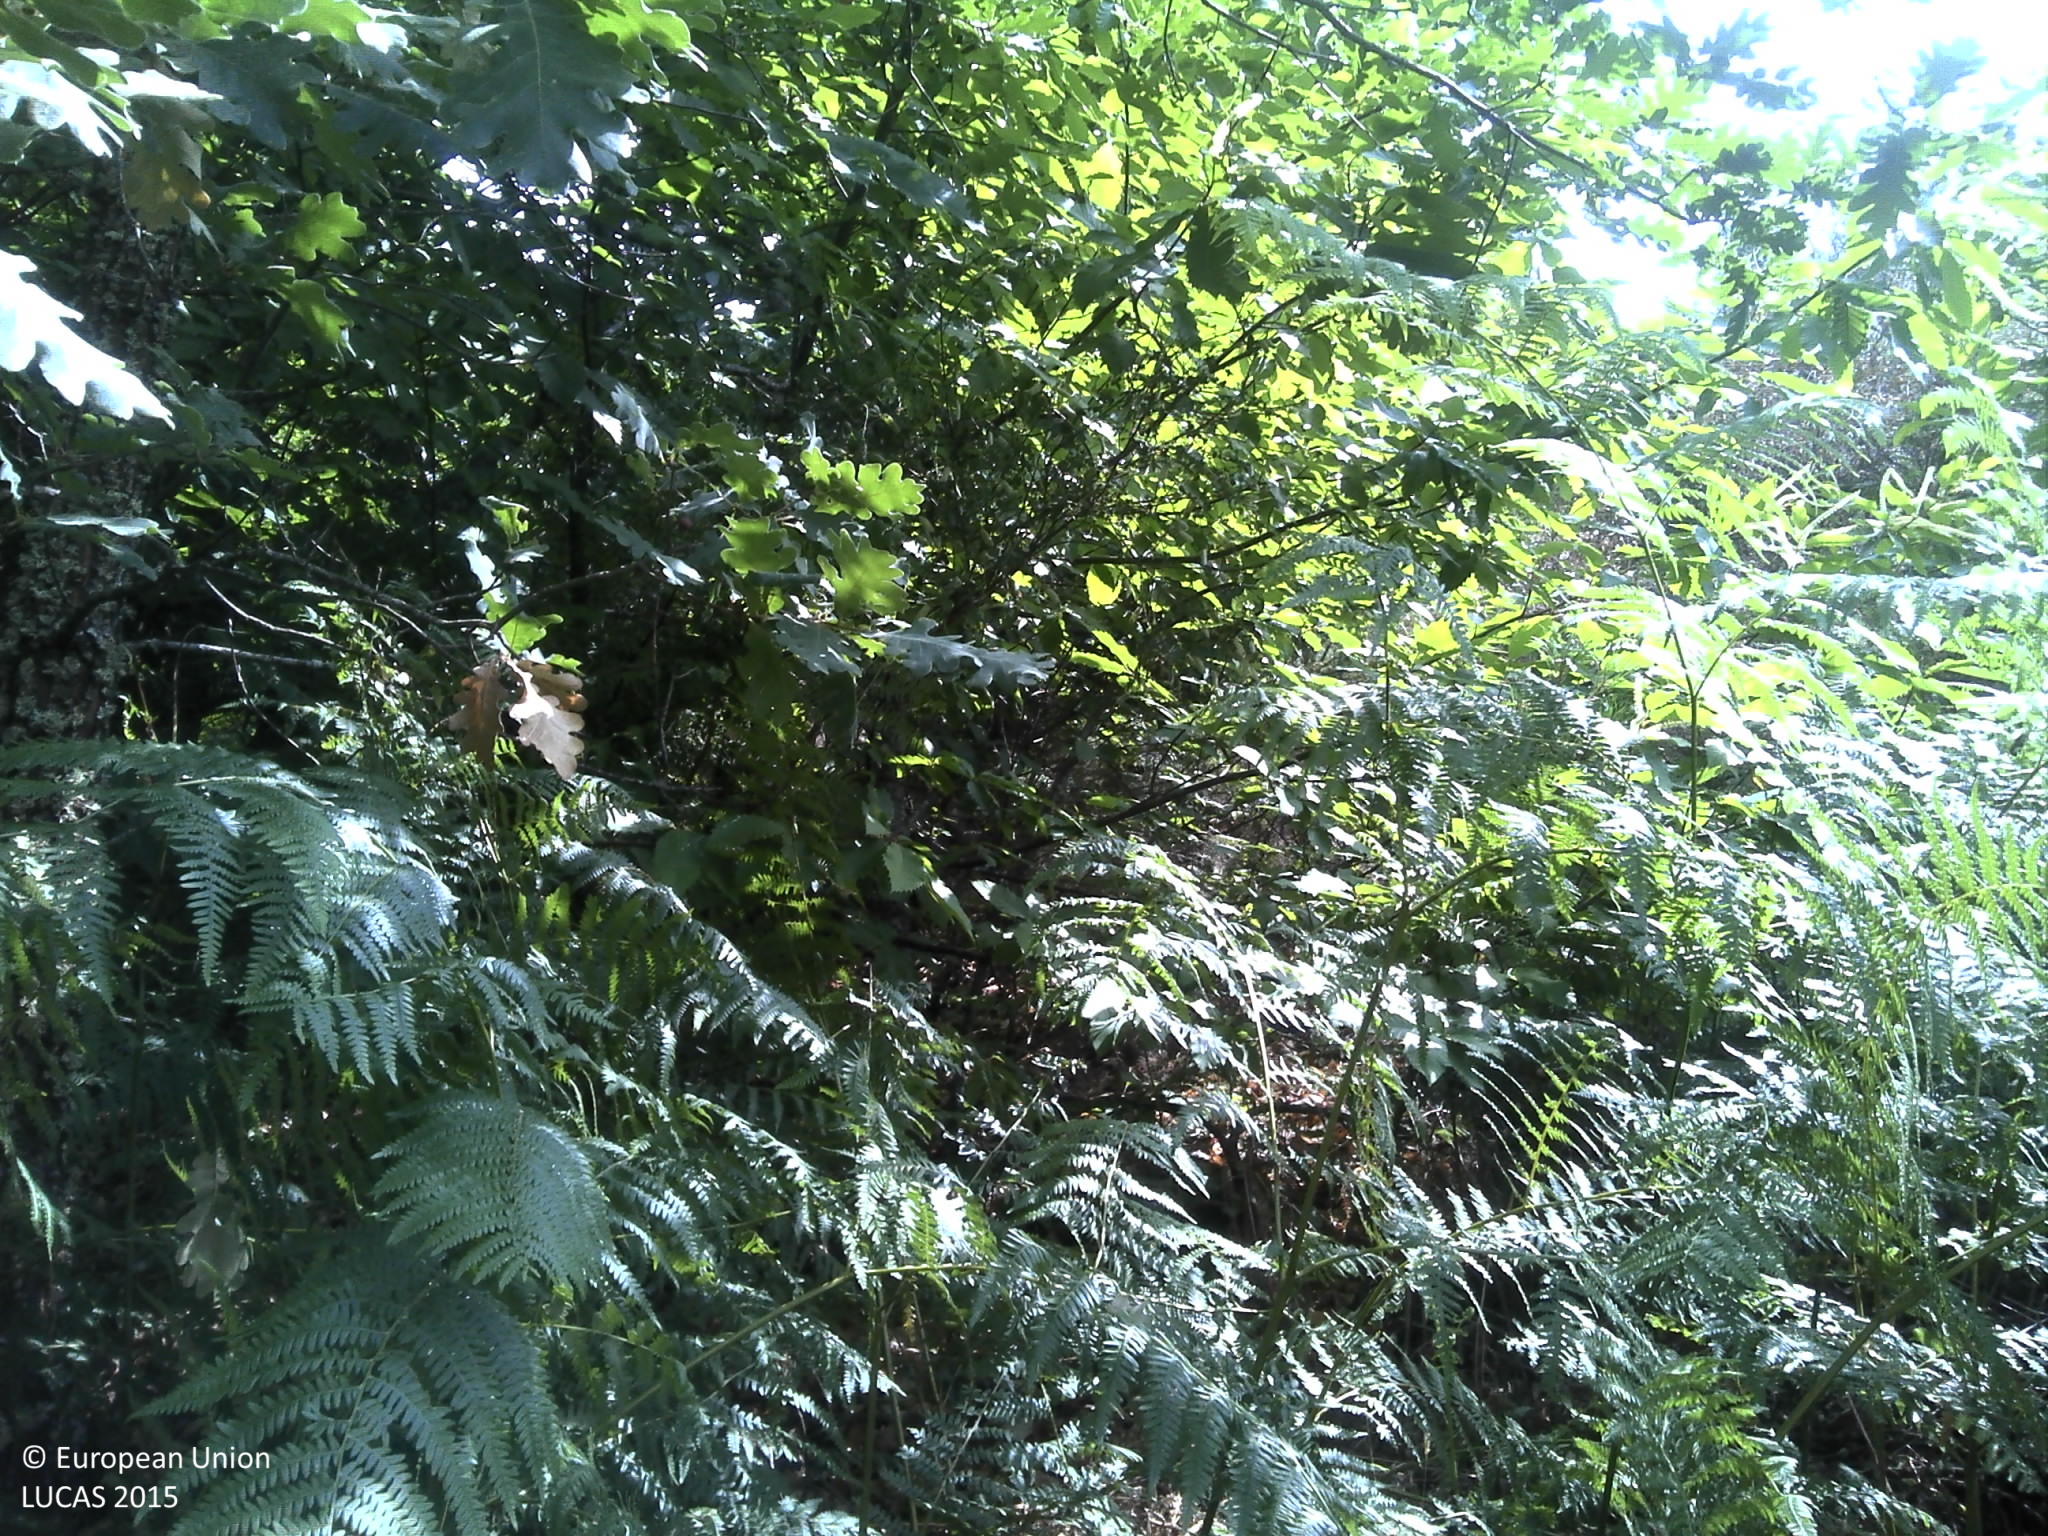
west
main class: Woodland
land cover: Pine dominated mixed woodland
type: coniferous forest of the mediterranean region
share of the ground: 50 - 75 %
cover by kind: coniferous forest trees 50 %, broadleaved forest trees 25 %, shrubs 20 %
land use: Forestry
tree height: > 5 m
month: June
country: PT
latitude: 40.2237
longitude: -7.4385
